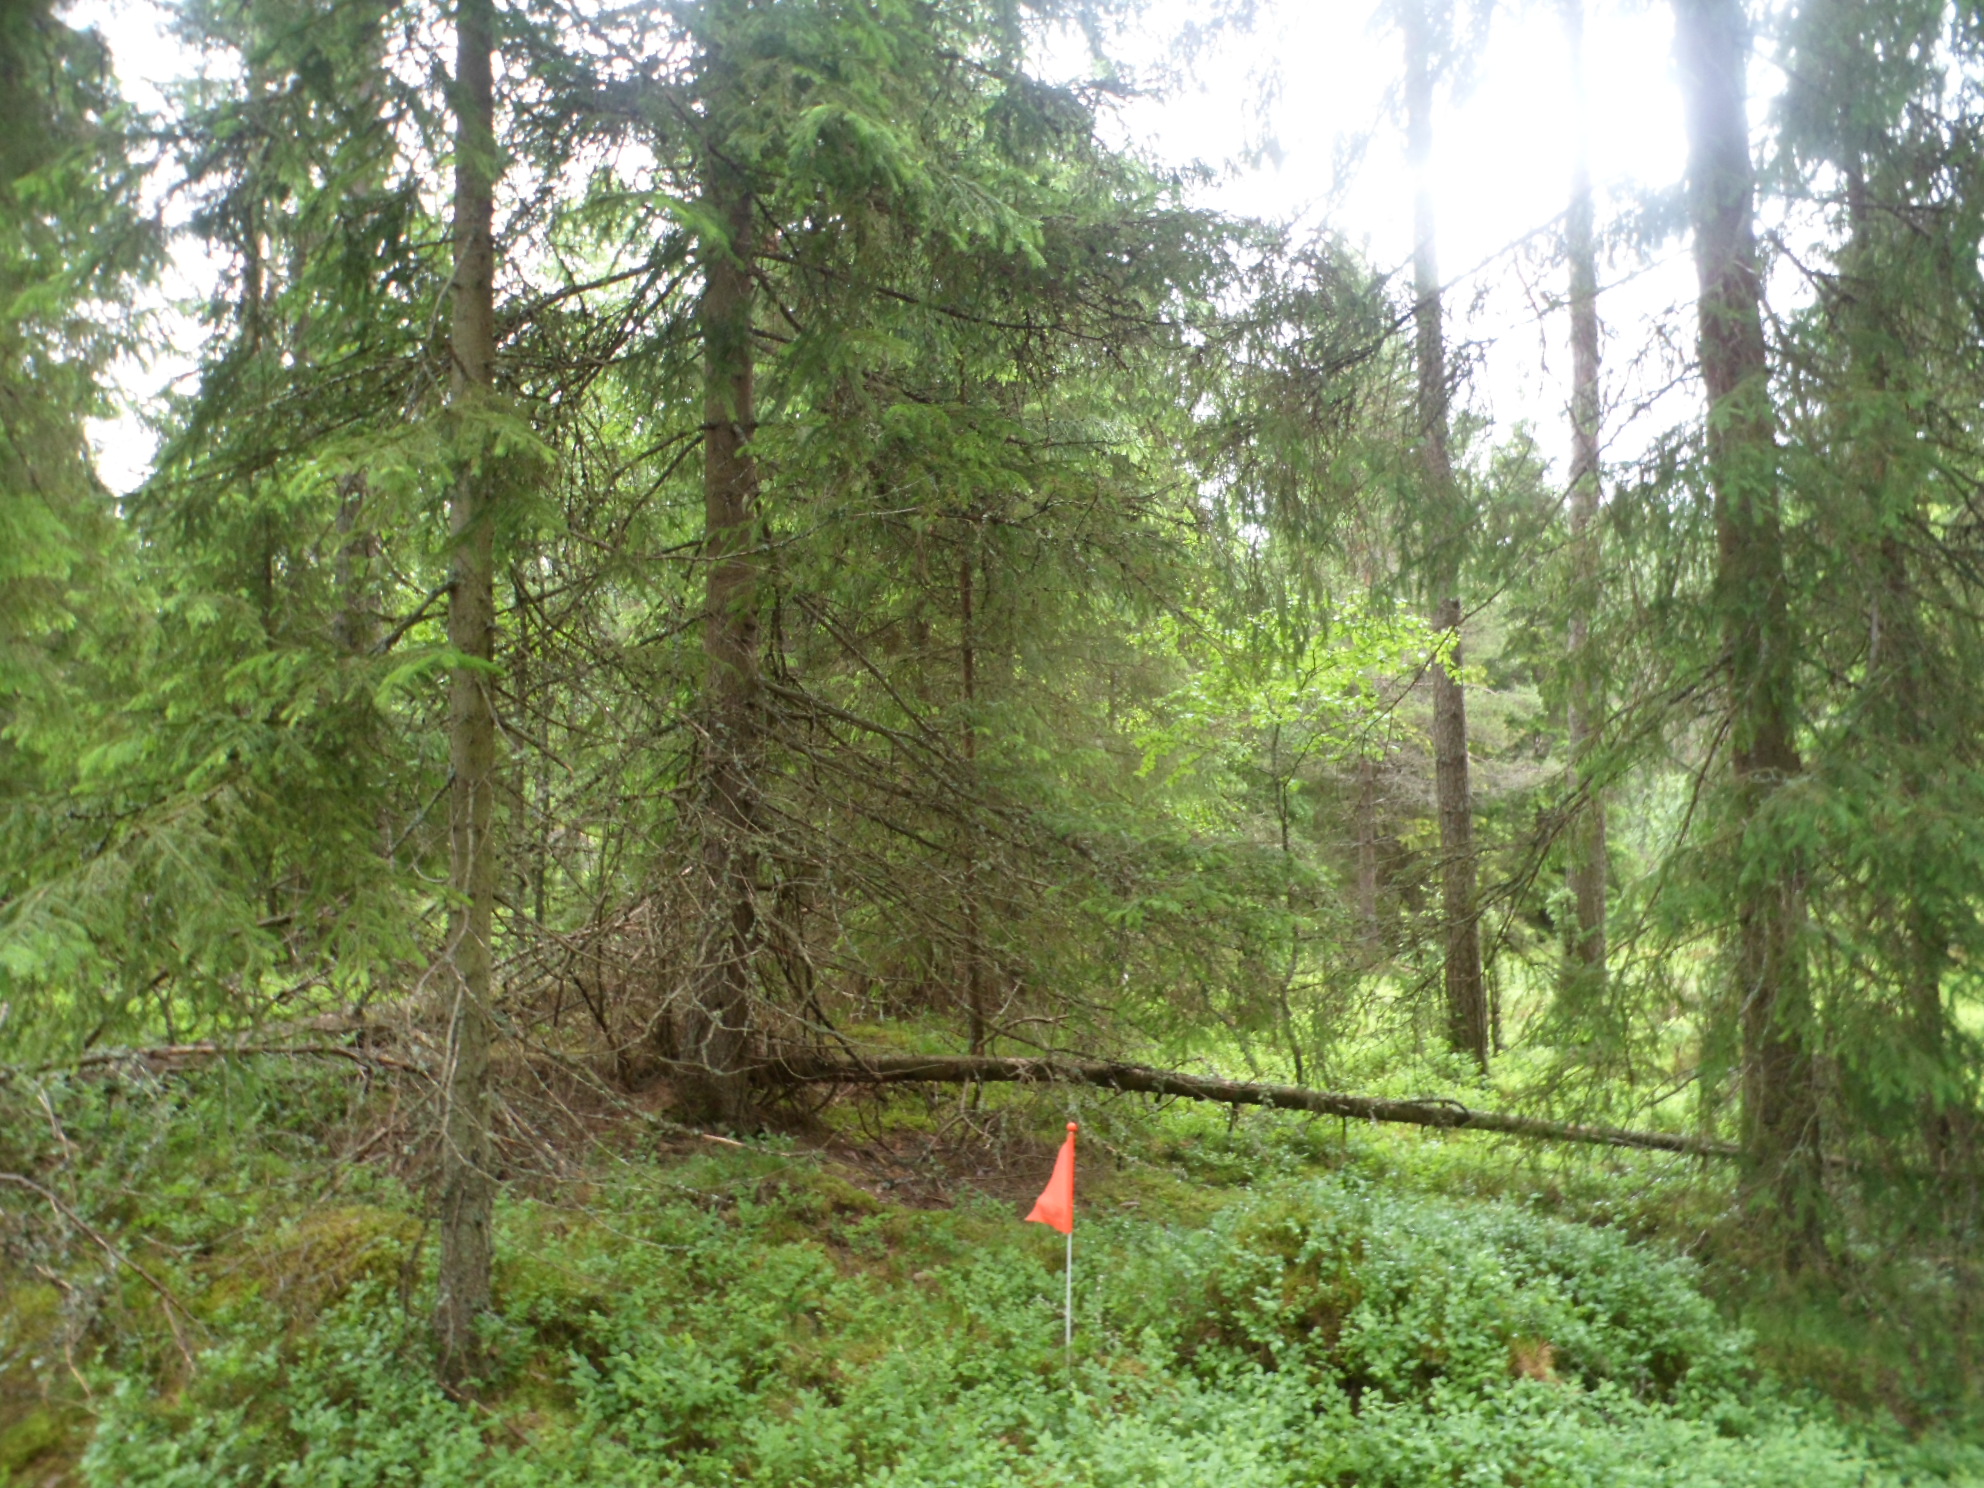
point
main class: Woodland
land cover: Spruce dominated coniferous woodland
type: boreal forest
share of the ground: 50 - 75 %
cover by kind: coniferous forest trees 55 %, shrubs 30 %, lichens and mosses 10 %, herbaceous plants 5 %
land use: Forestry
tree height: > 5 m
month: June
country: SE
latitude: 57.1455
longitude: 15.2032
